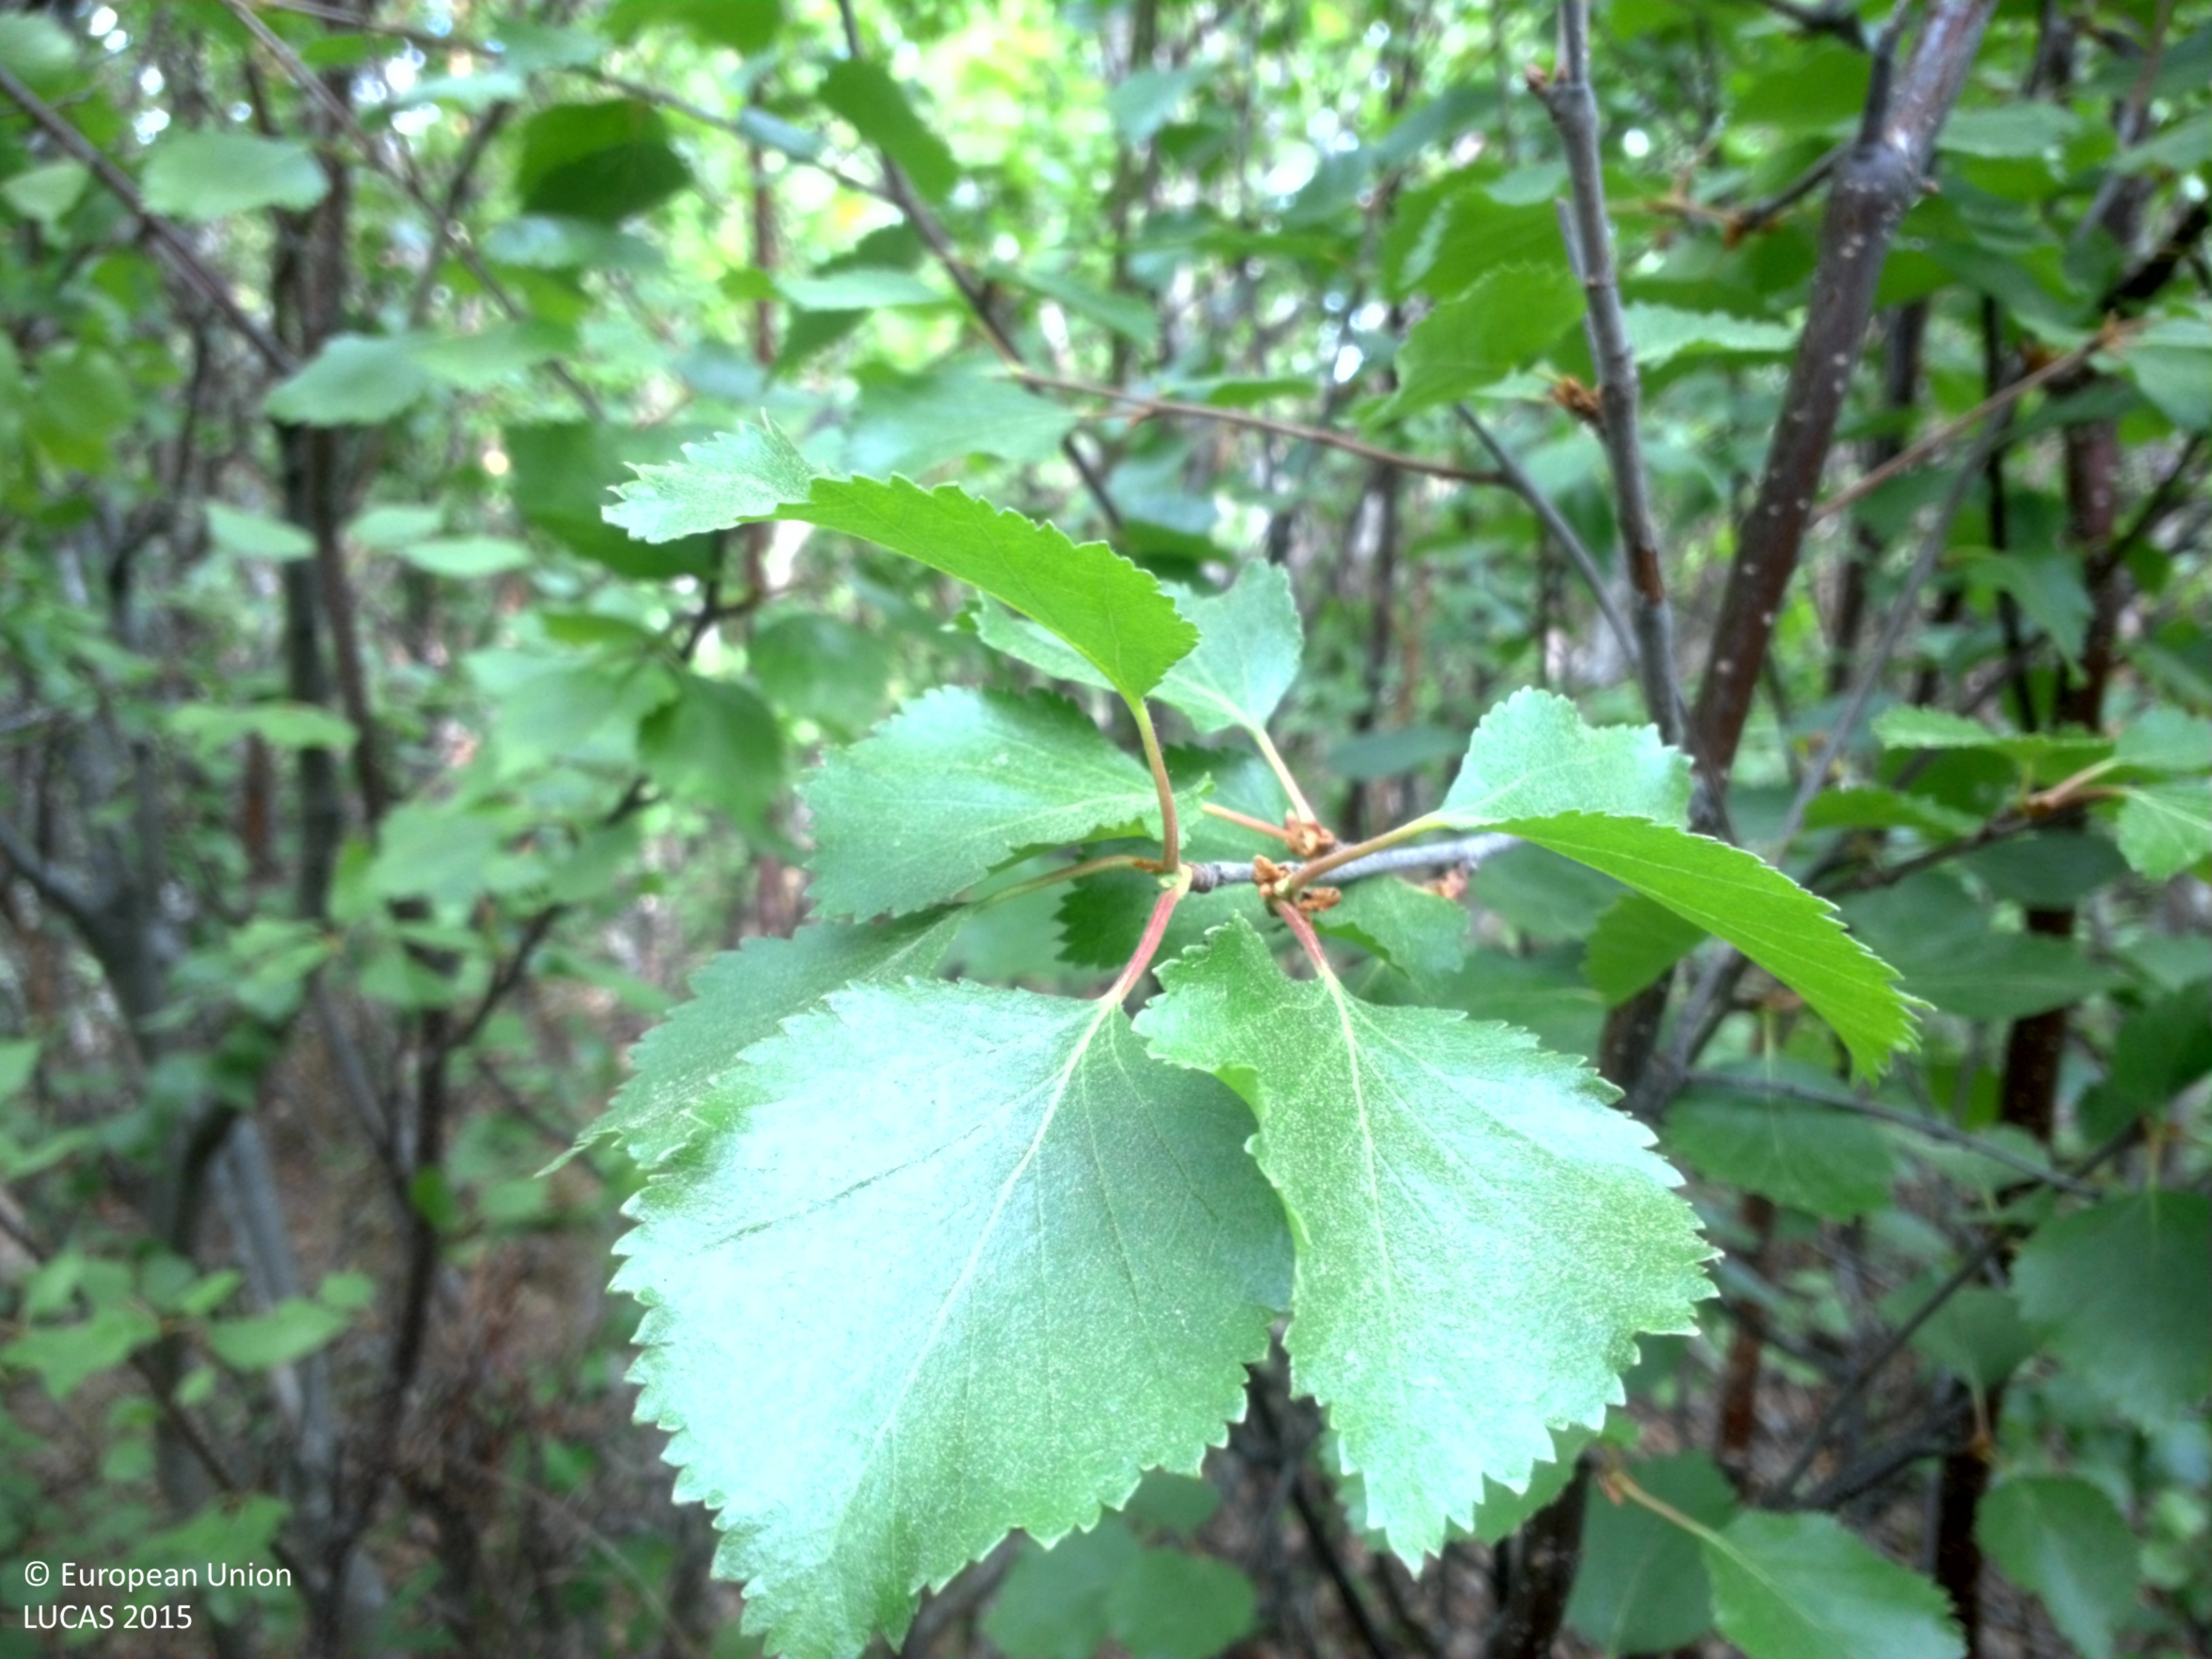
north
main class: Woodland
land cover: Broadleaved woodland
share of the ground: > 75 %
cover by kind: broadleaved forest trees 90 %, coniferous forest trees 5 %, shrubs 5 %
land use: Forestry
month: July
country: SE
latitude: 67.5050
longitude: 18.4433
